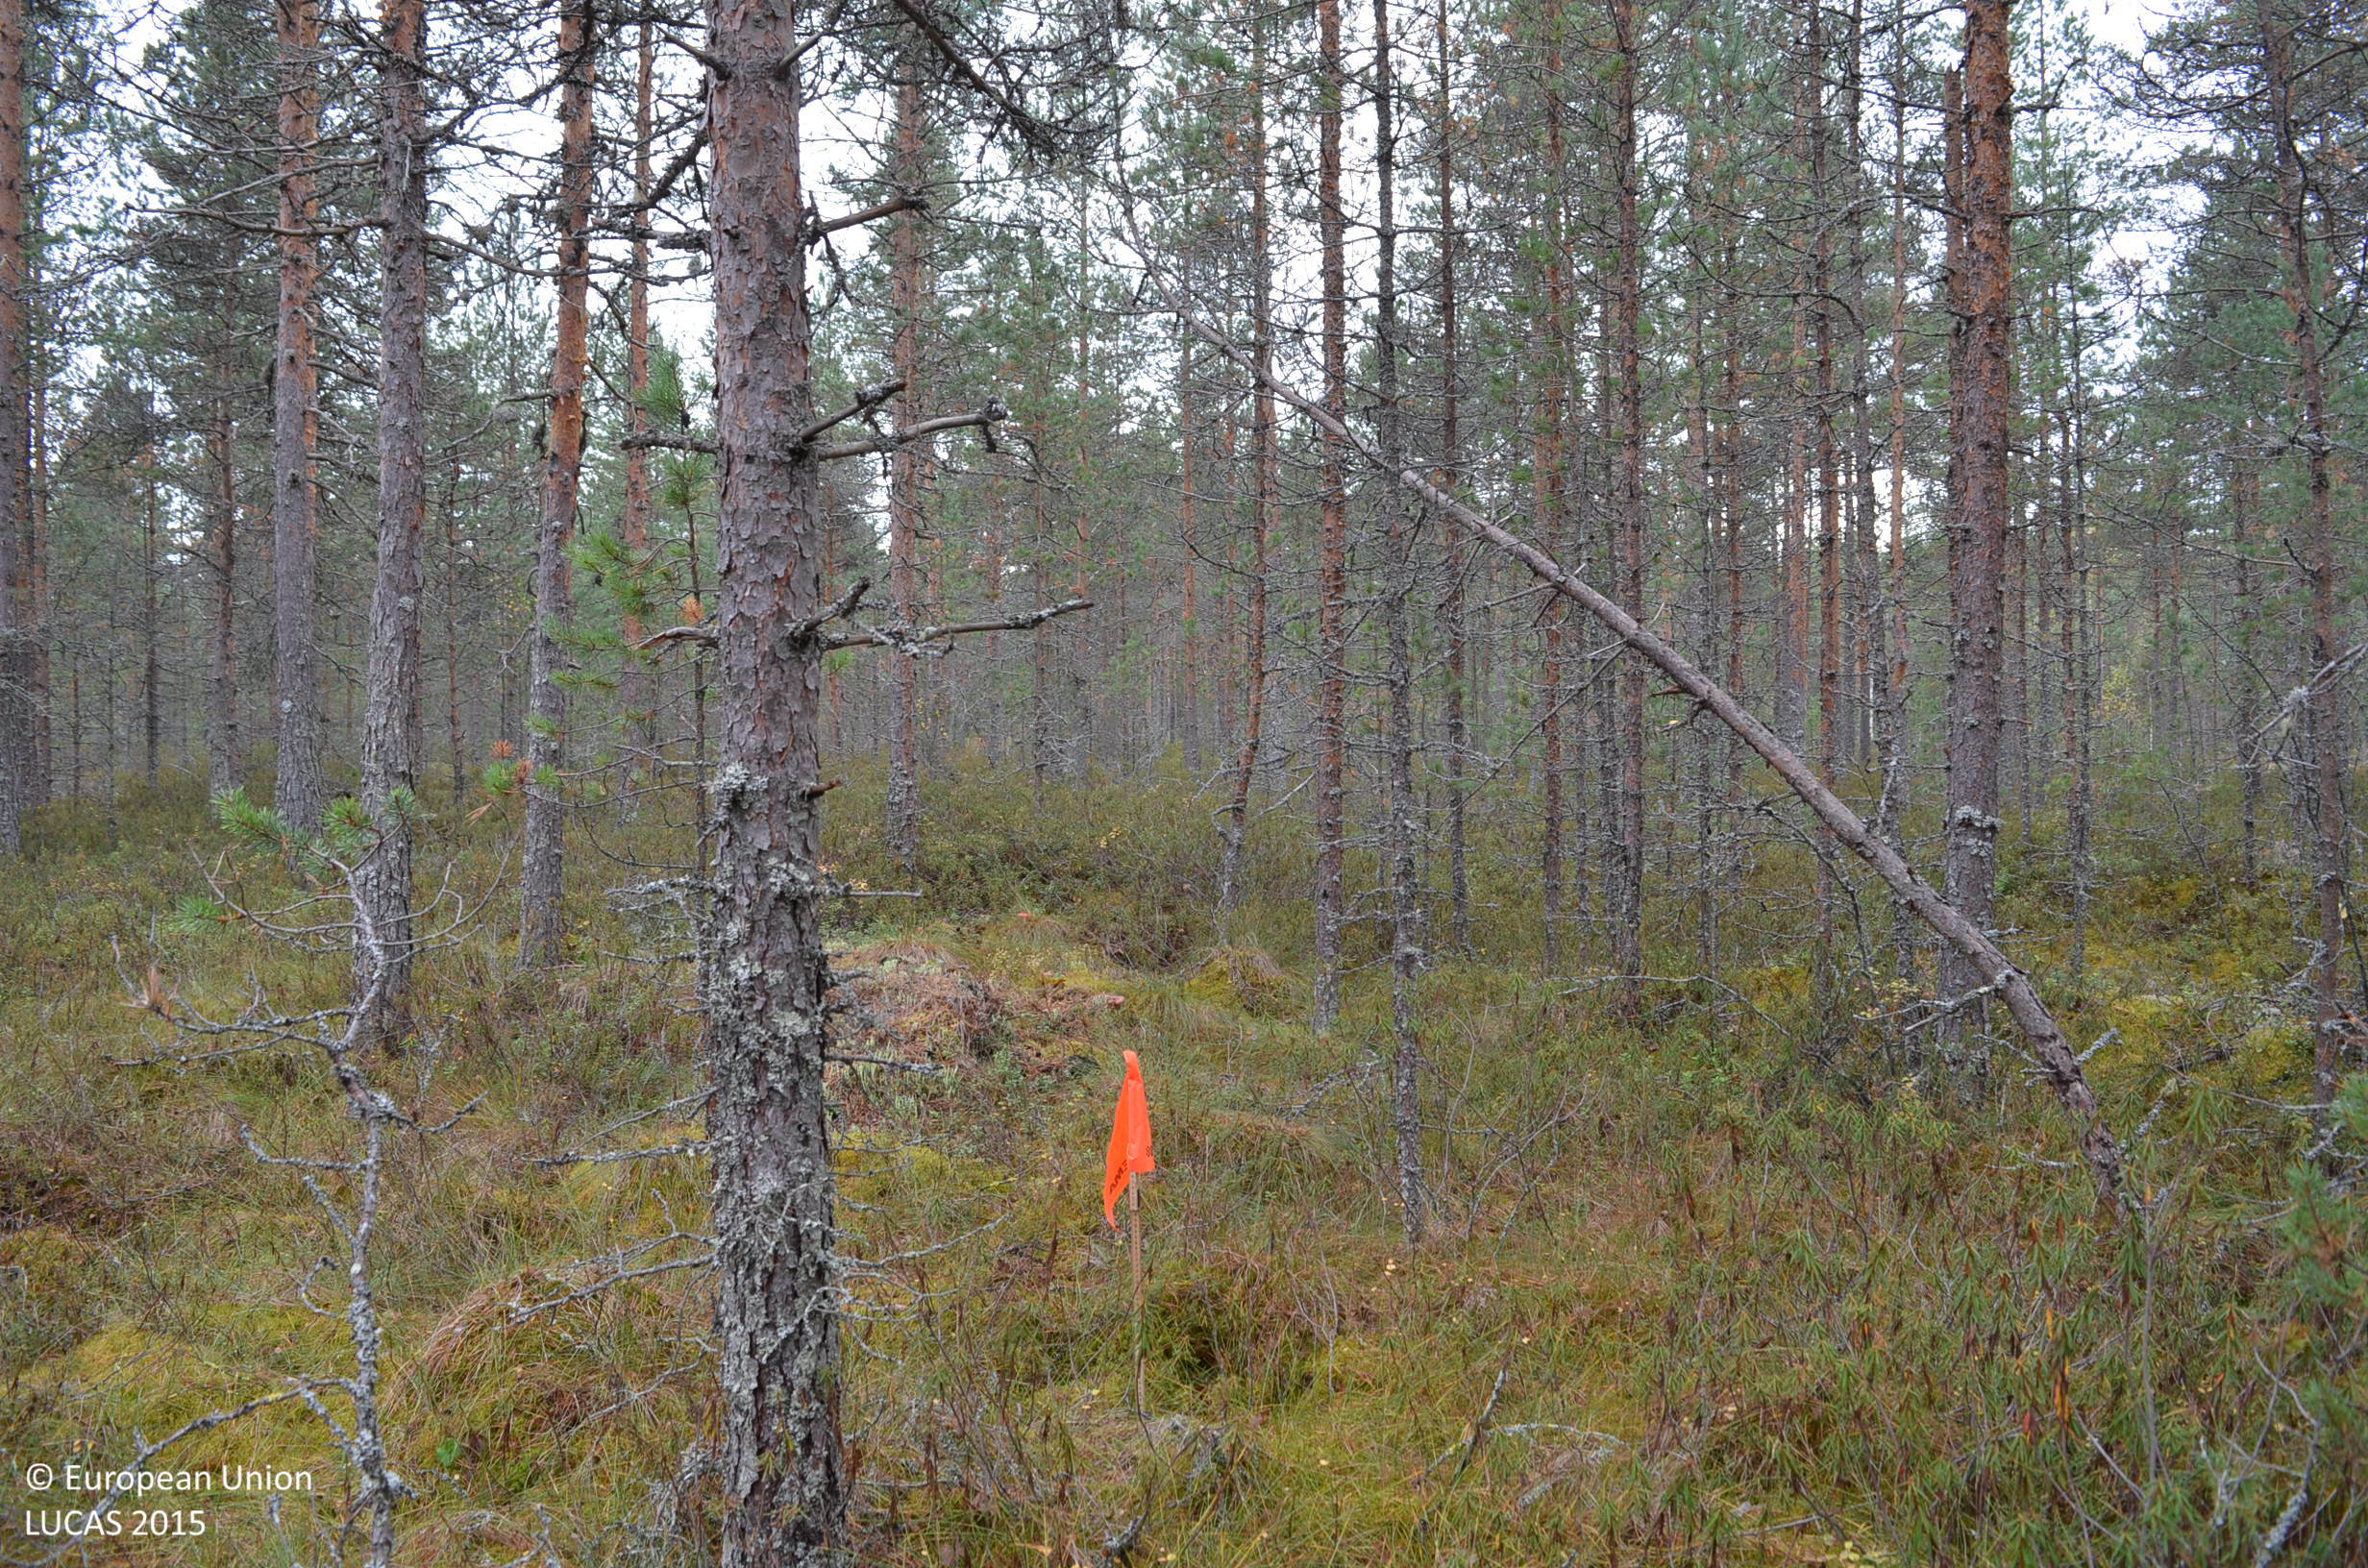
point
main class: Woodland
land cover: Pine dominated coniferous woodland
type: mire and swamp forests
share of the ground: 50 - 75 %
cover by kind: coniferous forest trees 65 %, shrubs 25 %, herbaceous plants 5 %, lichens and mosses 5 %
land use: Forestry
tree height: > 5 m
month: October
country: FI
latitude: 62.3883
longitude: 23.4744
